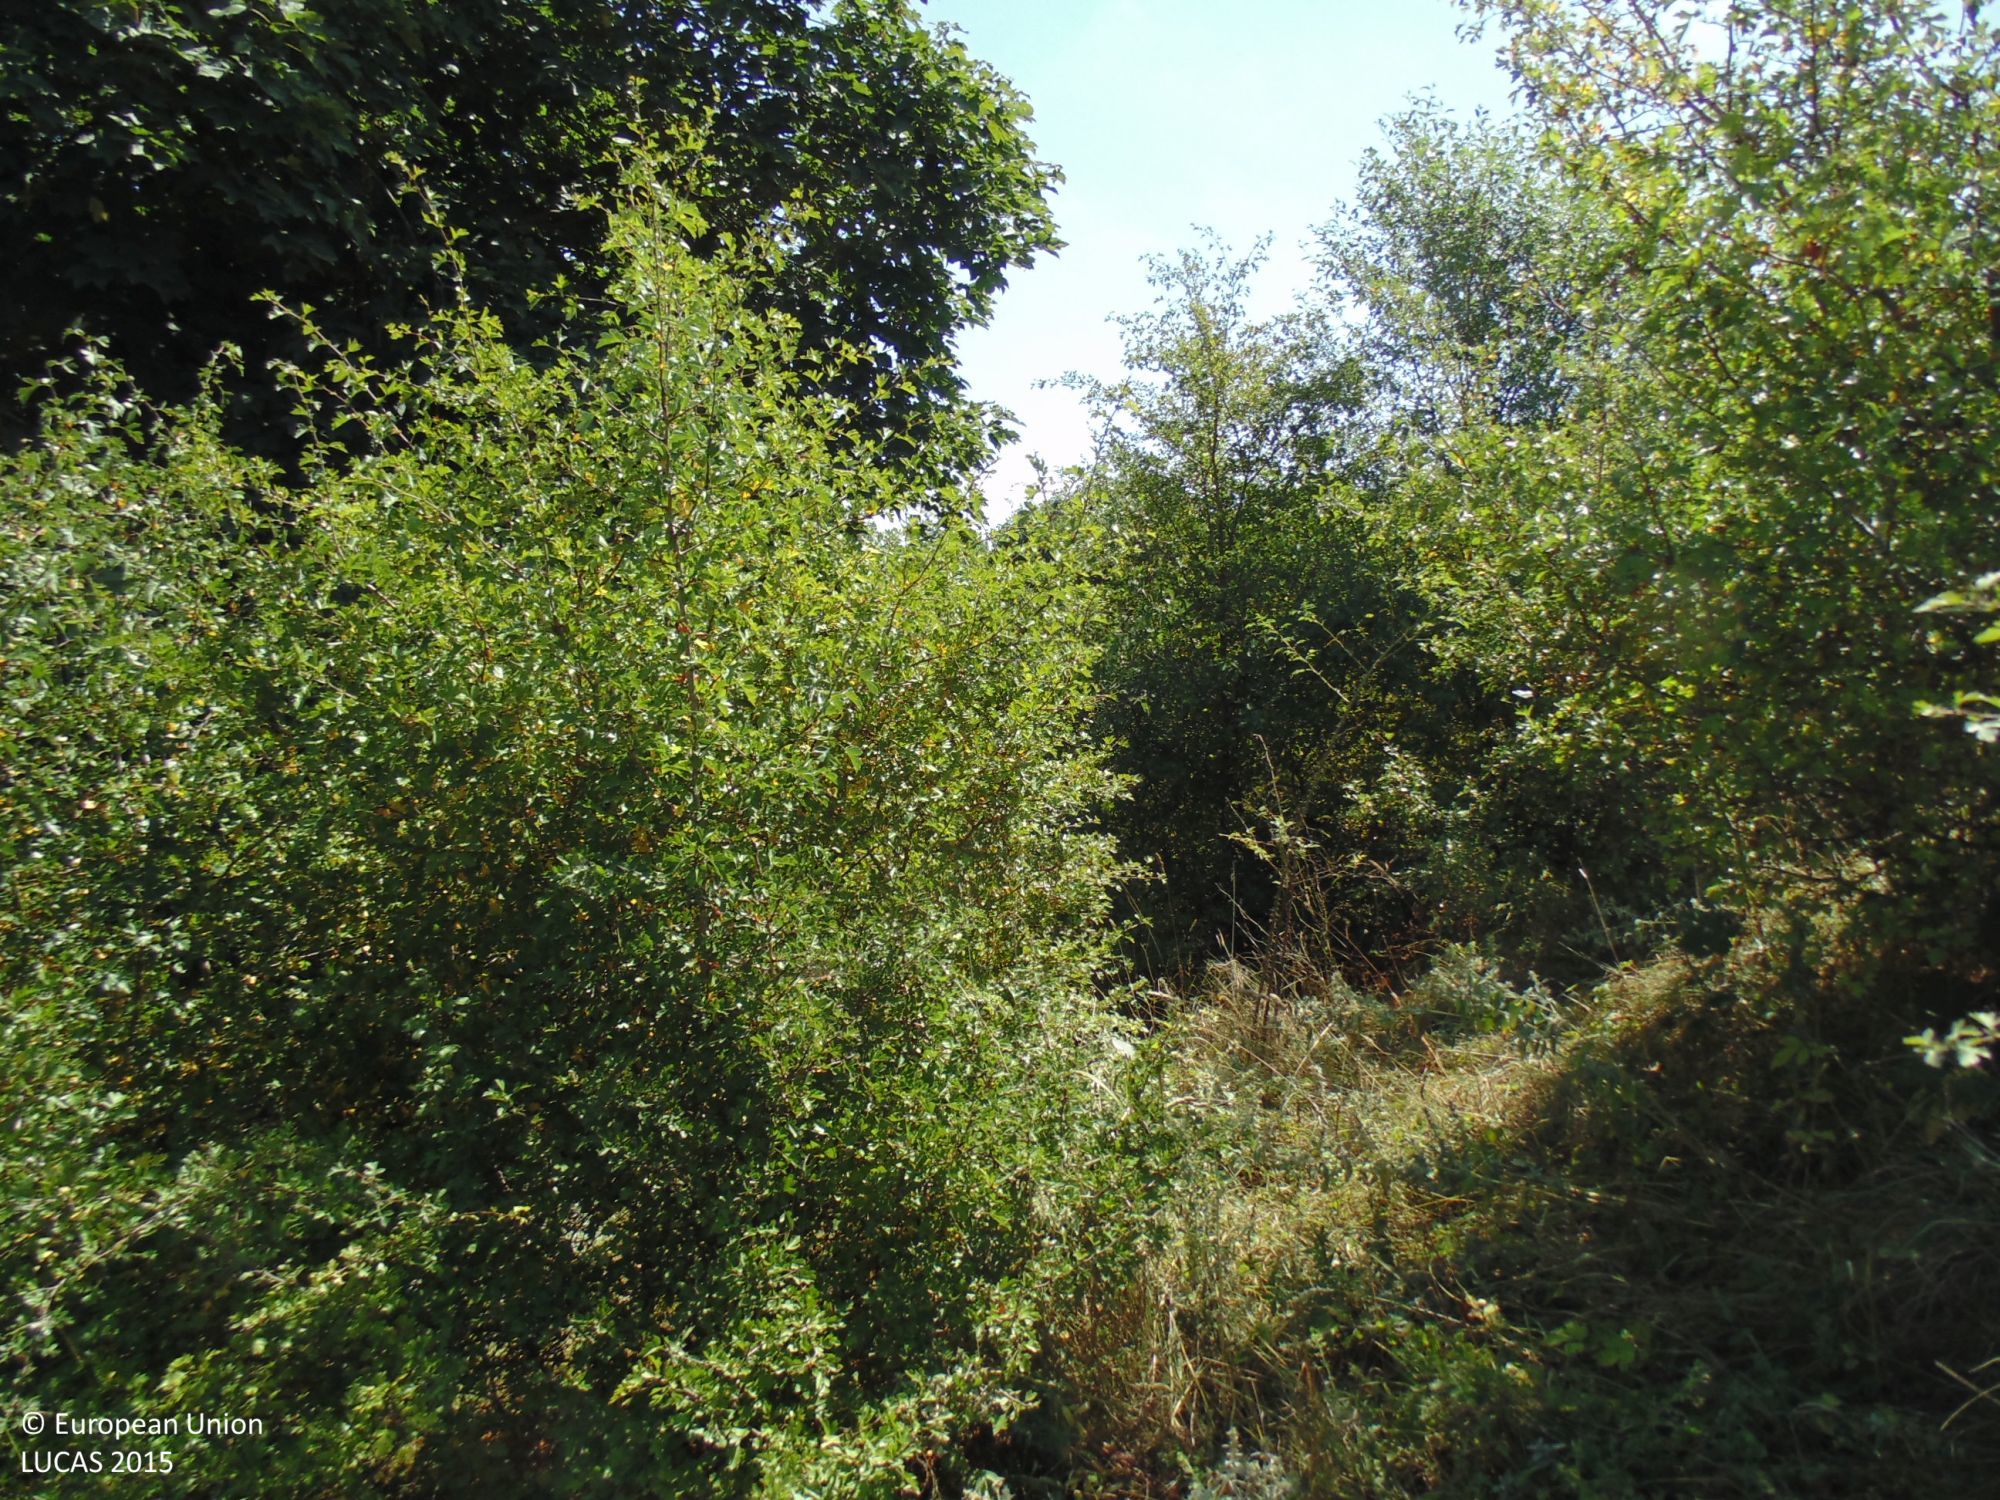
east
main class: Woodland
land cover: Broadleaved woodland
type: mesophytic deciduous forest
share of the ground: 25 - 50 %
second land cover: Grassland without tree/shrub cover
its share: > 75 %
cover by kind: herbaceous plants 70 %, broadleaved forest trees 25 %, shrubs 5 %
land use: Forestry
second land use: Agriculture (excluding fallow land and kitchen gardens)
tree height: < 5 m
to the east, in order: Broadleaved woodland; Grassland without tree/shrub cover; Grassland with sparse tree/shrub cover; Broadleaved woodland; Grass margins; Paved roads, cycling and walking lanes; Grass margins; Artificial constructions in urban areas; Grassland without tree/shrub cover
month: August
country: BG
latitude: 43.6397
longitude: 28.1383
